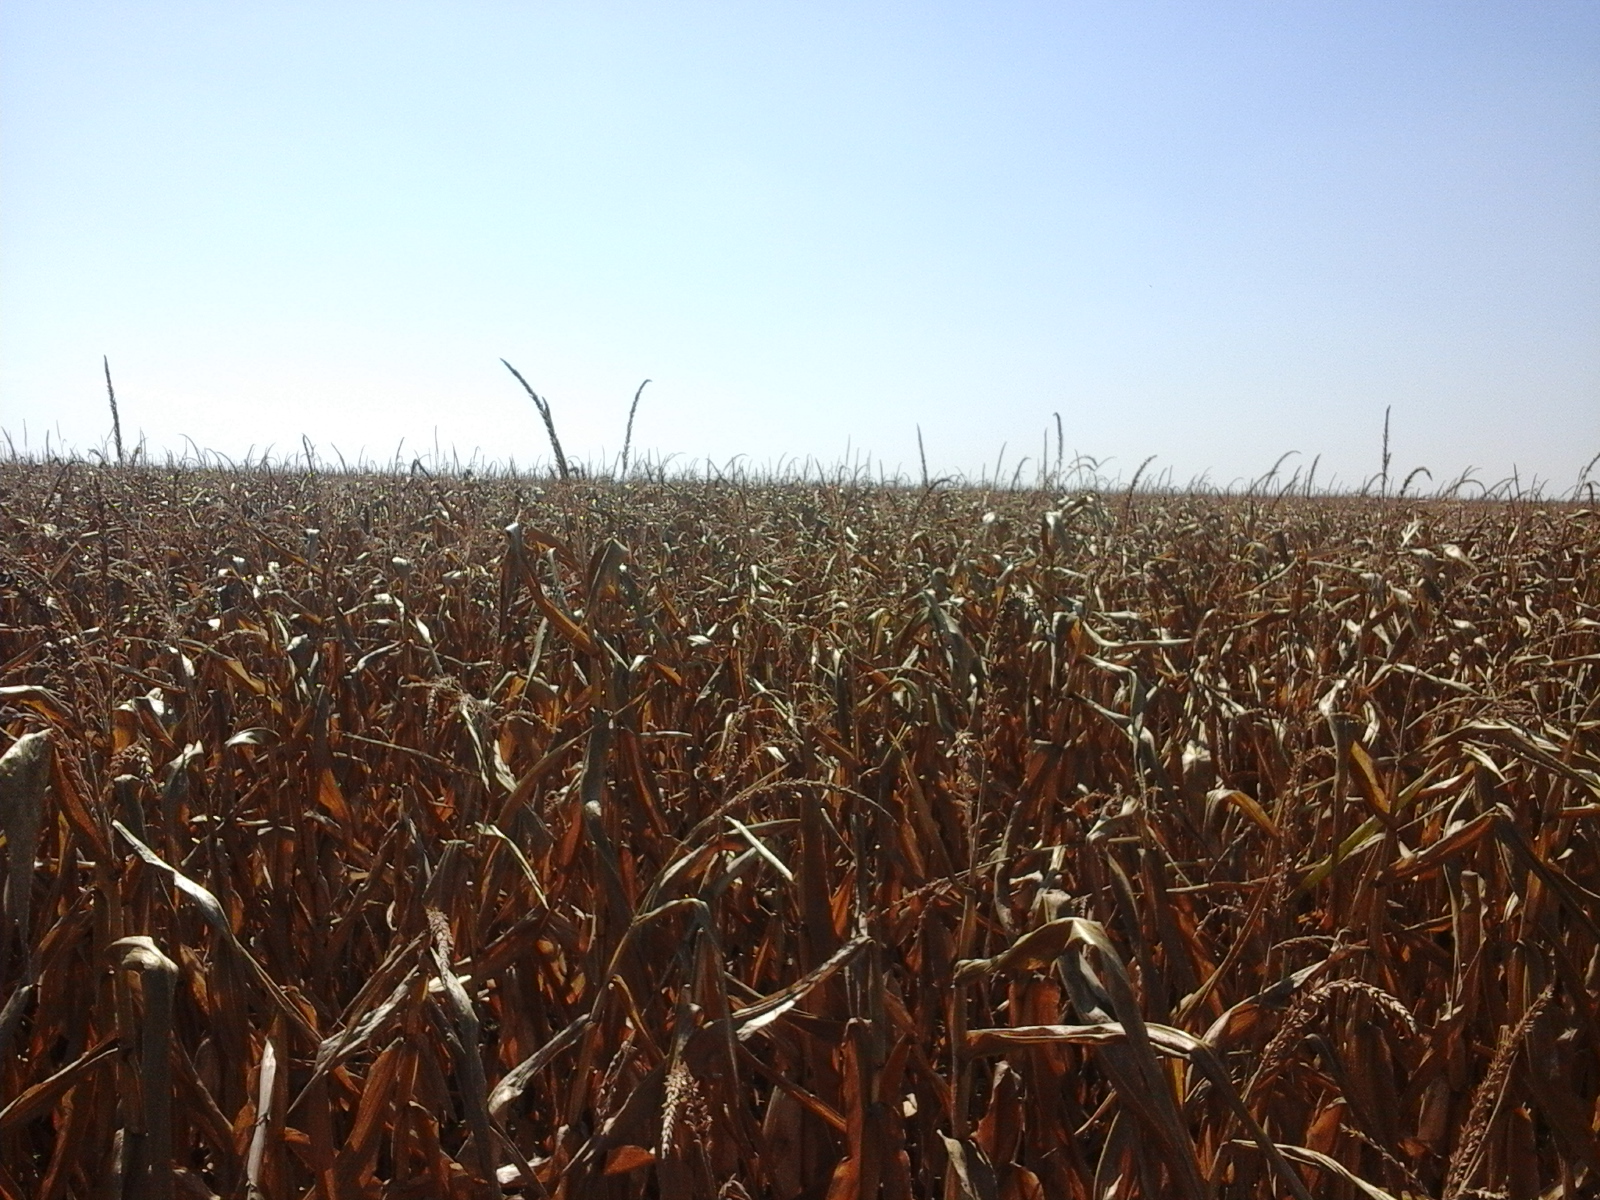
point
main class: Cropland
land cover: Maize
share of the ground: > 75 %
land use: Agriculture (excluding fallow land and kitchen gardens)
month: August
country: RO
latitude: 45.8862
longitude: 21.0468
